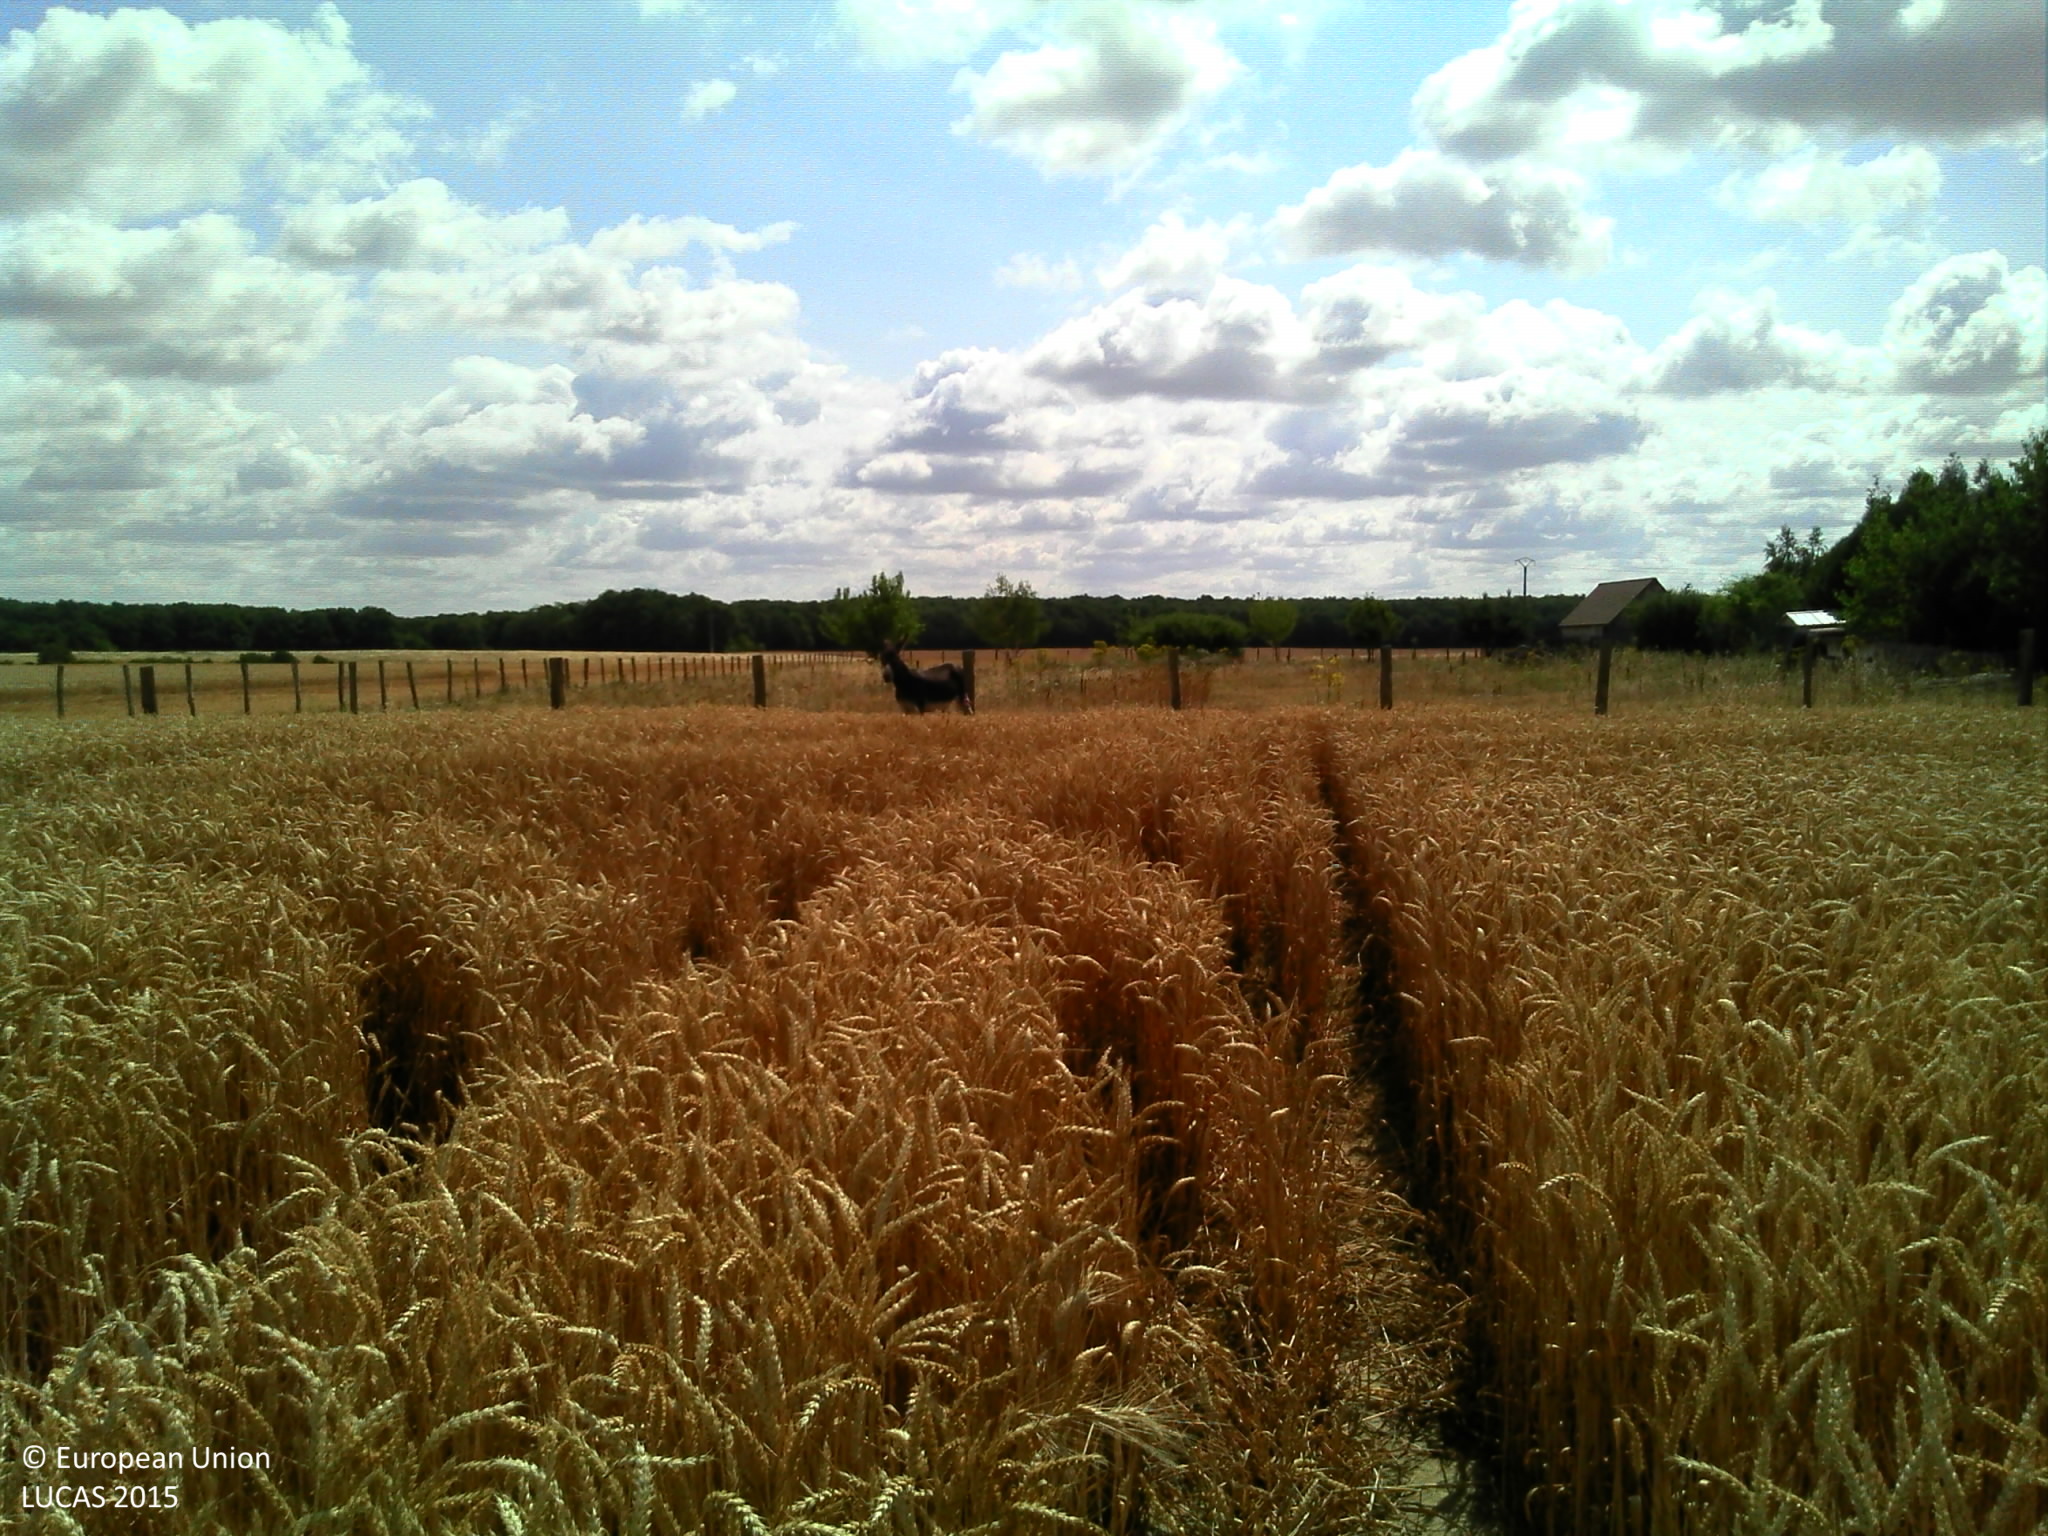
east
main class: Cropland
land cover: Common wheat
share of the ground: > 75 %
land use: Agriculture (excluding fallow land and kitchen gardens)
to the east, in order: Common wheat; Fences; Grassland without tree/shrub cover; Grassland with sparse tree/shrub cover; Fences; Common wheat
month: July
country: FR
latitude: 48.0969
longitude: 2.8080
